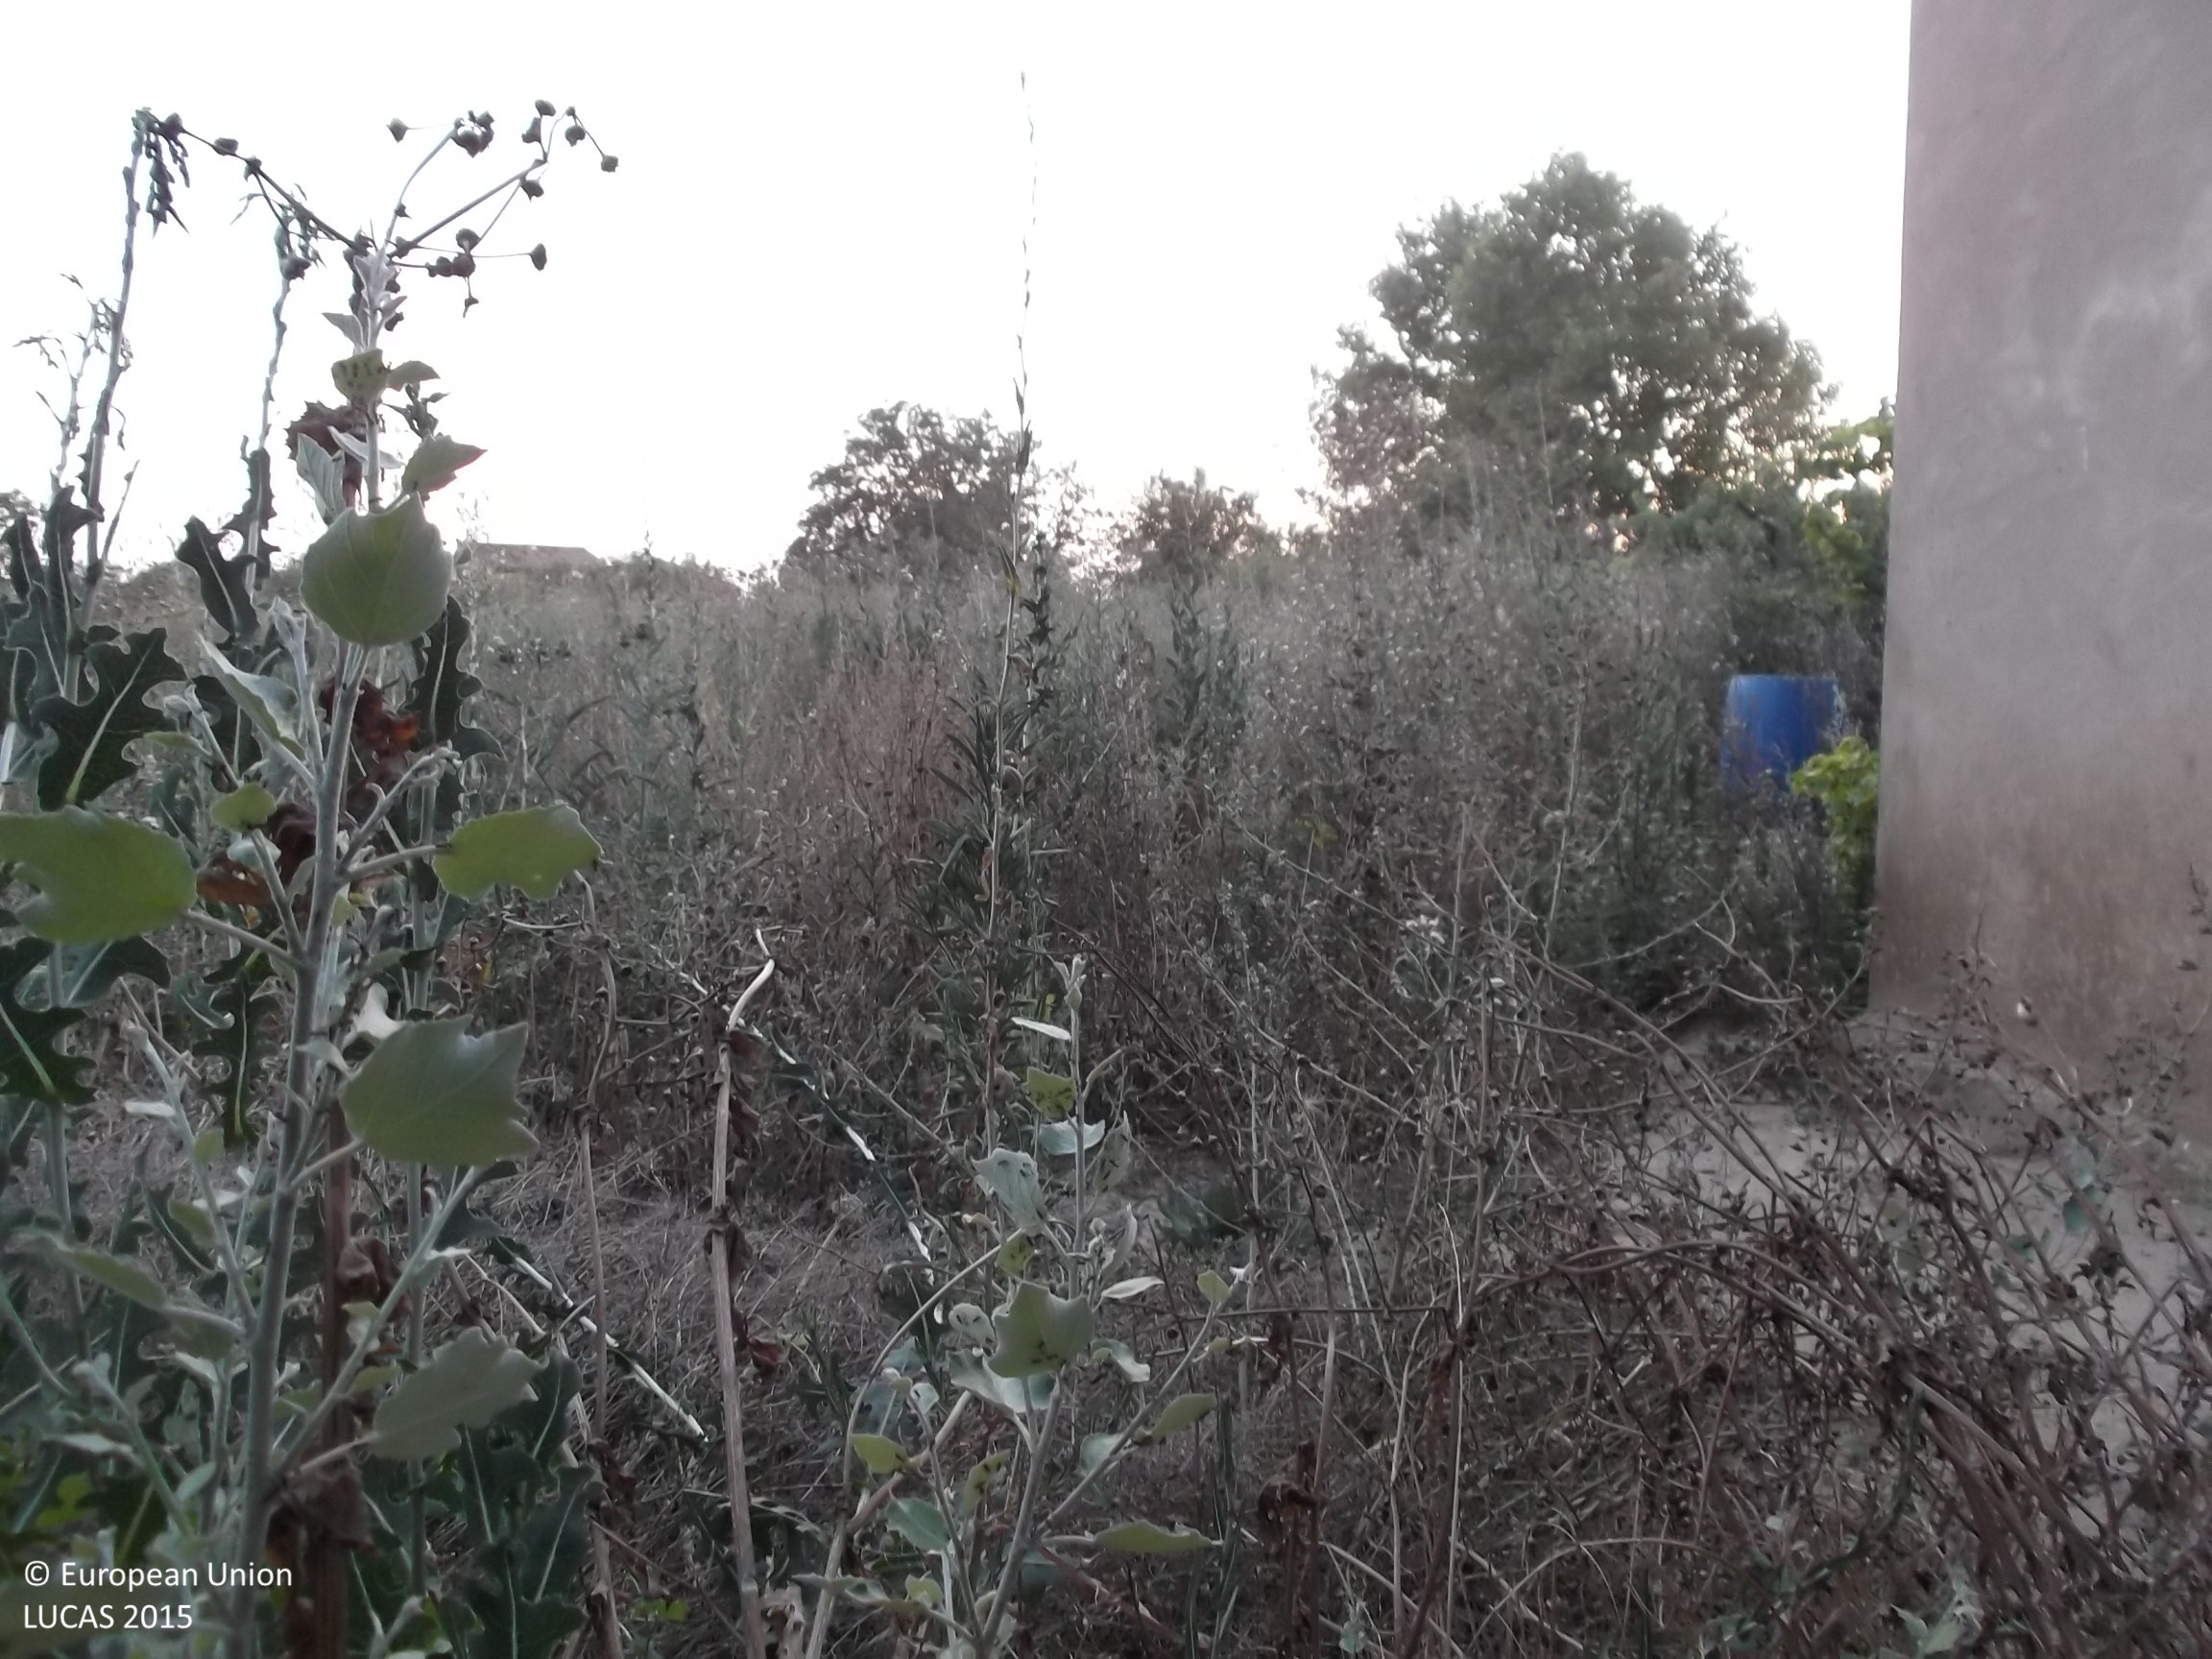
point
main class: Grassland
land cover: Spontaneously vegetated surfaces
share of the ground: > 75 %
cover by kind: herbaceous plants 90 %, unconsolidated bare surface 10 %
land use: Abandoned areas
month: July
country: ES
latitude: 42.4562
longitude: -1.6242
